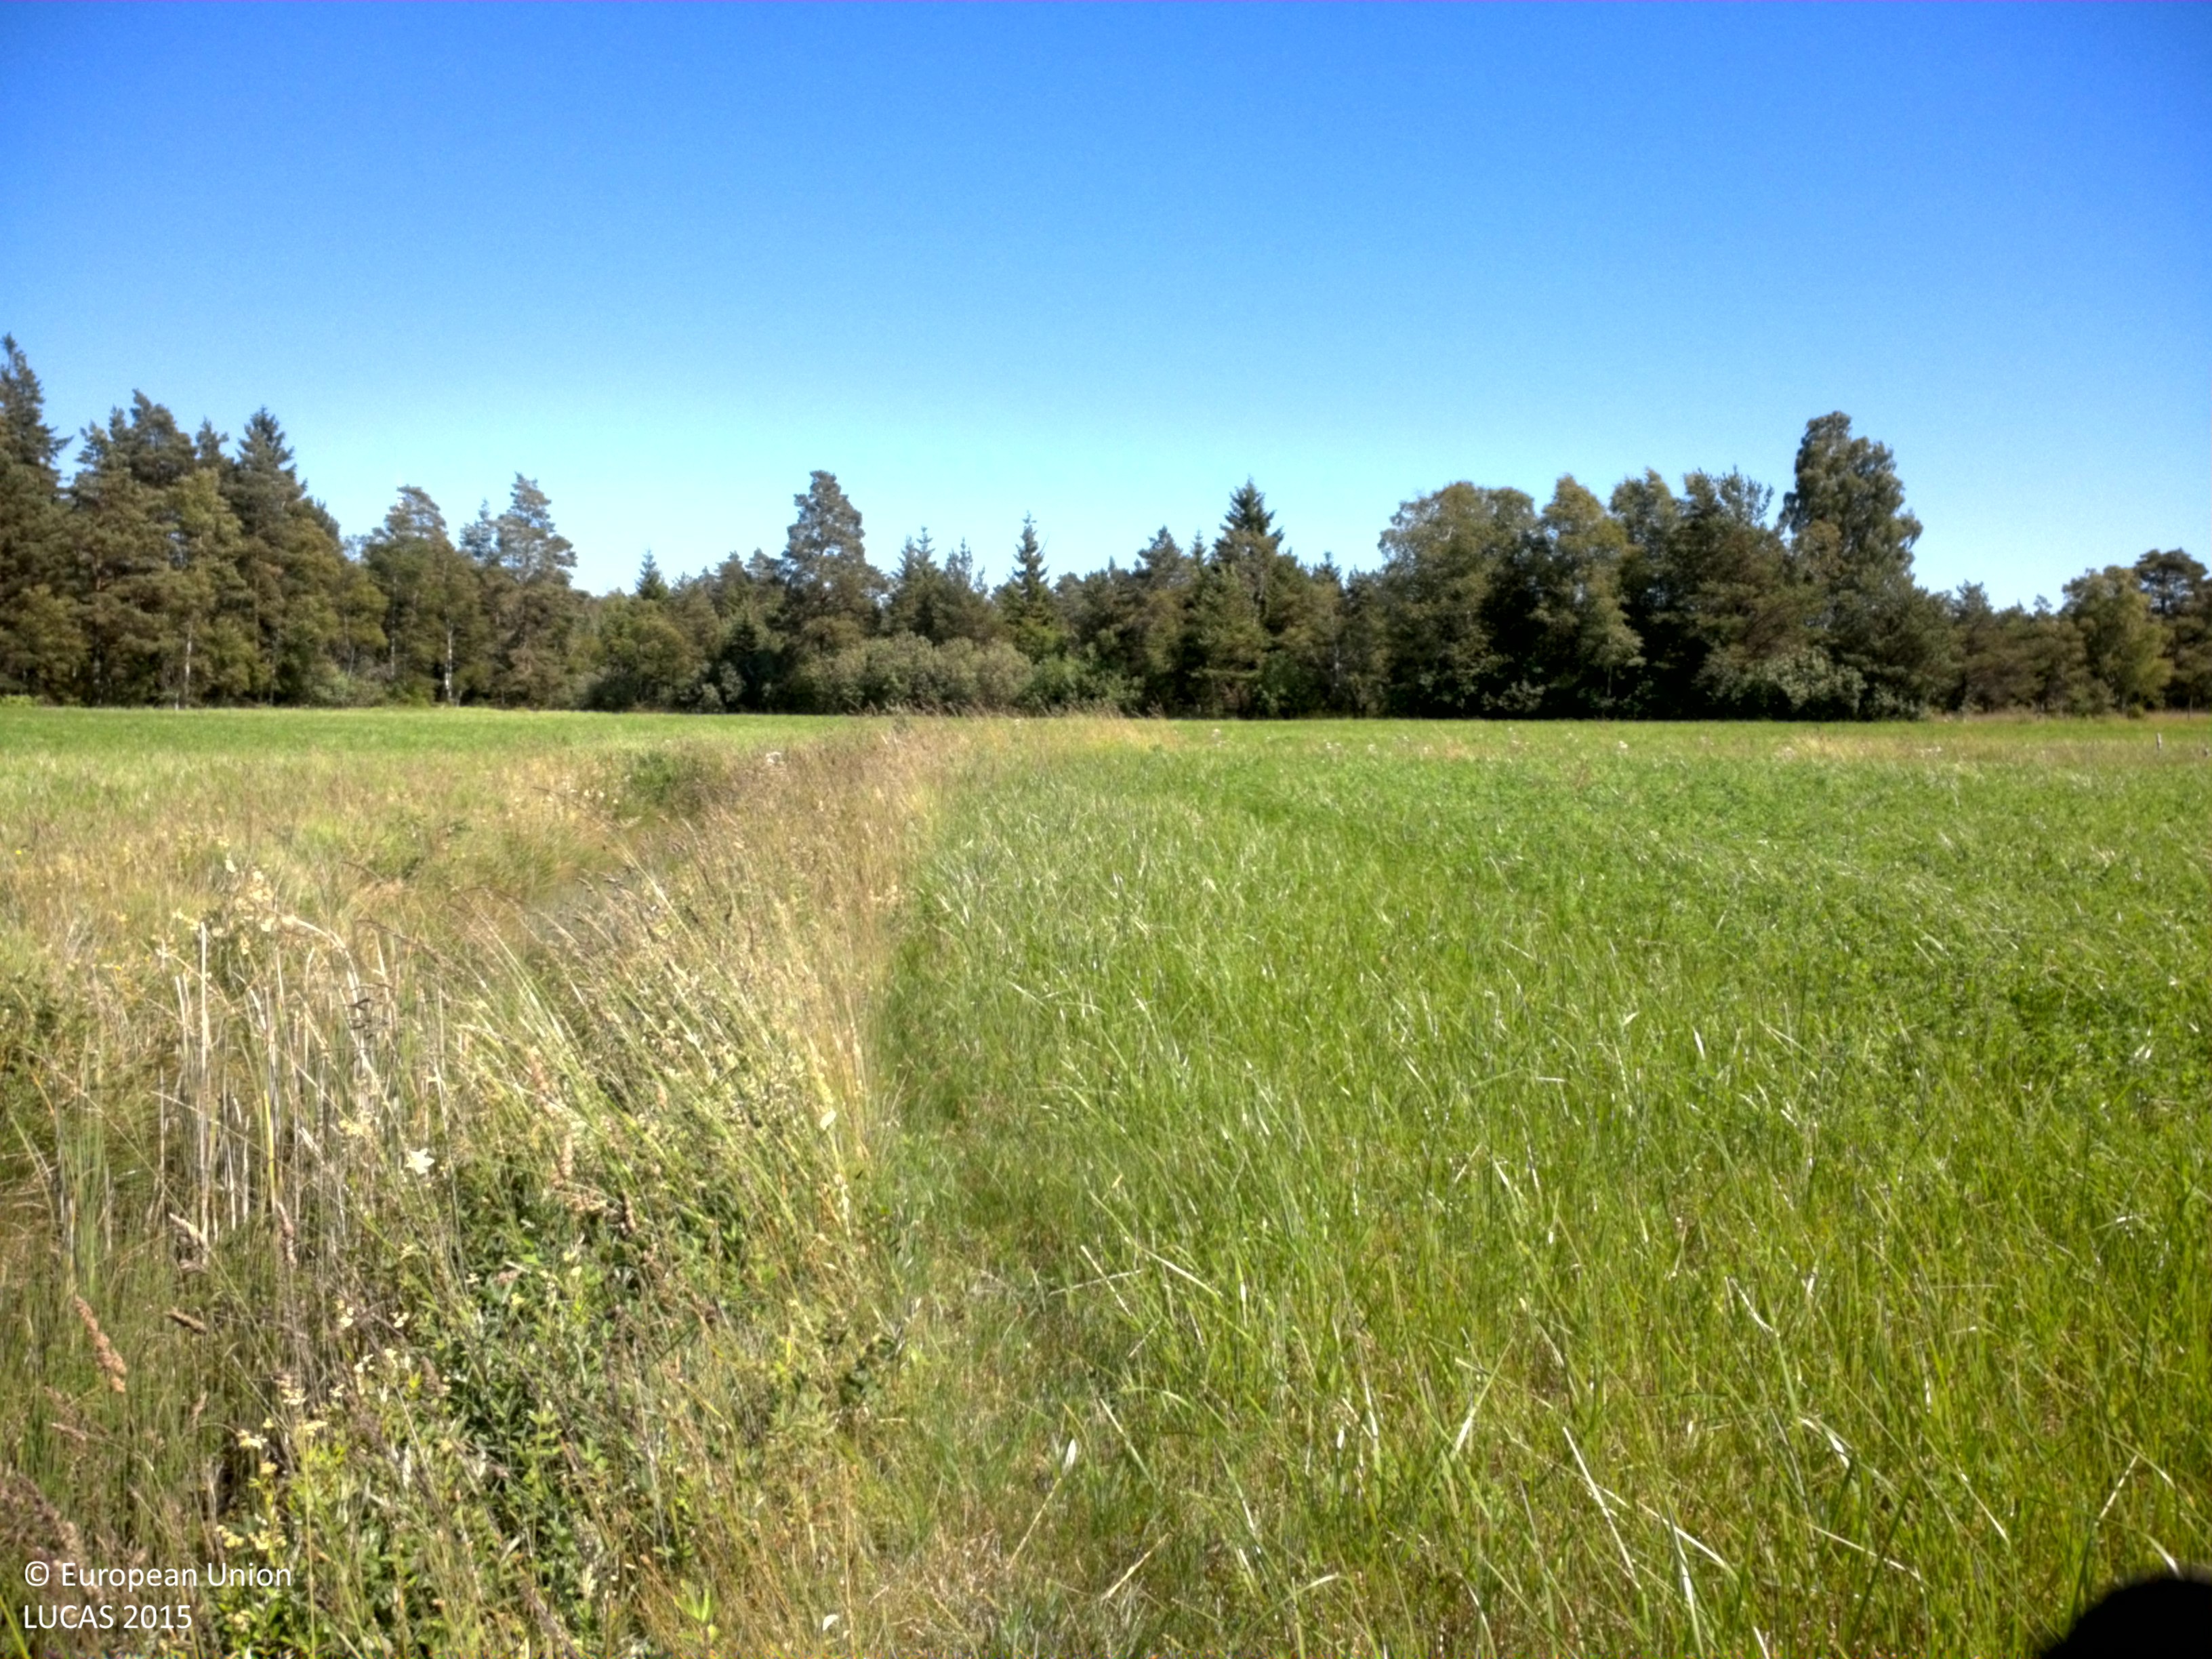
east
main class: Cropland
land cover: Lucerne
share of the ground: > 75 %
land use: Agriculture (excluding fallow land and kitchen gardens)
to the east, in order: Lucerne; Fences; Abandoned hedges; Pine dominated coniferous woodland
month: July
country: SE
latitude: 57.8075
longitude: 18.7434
